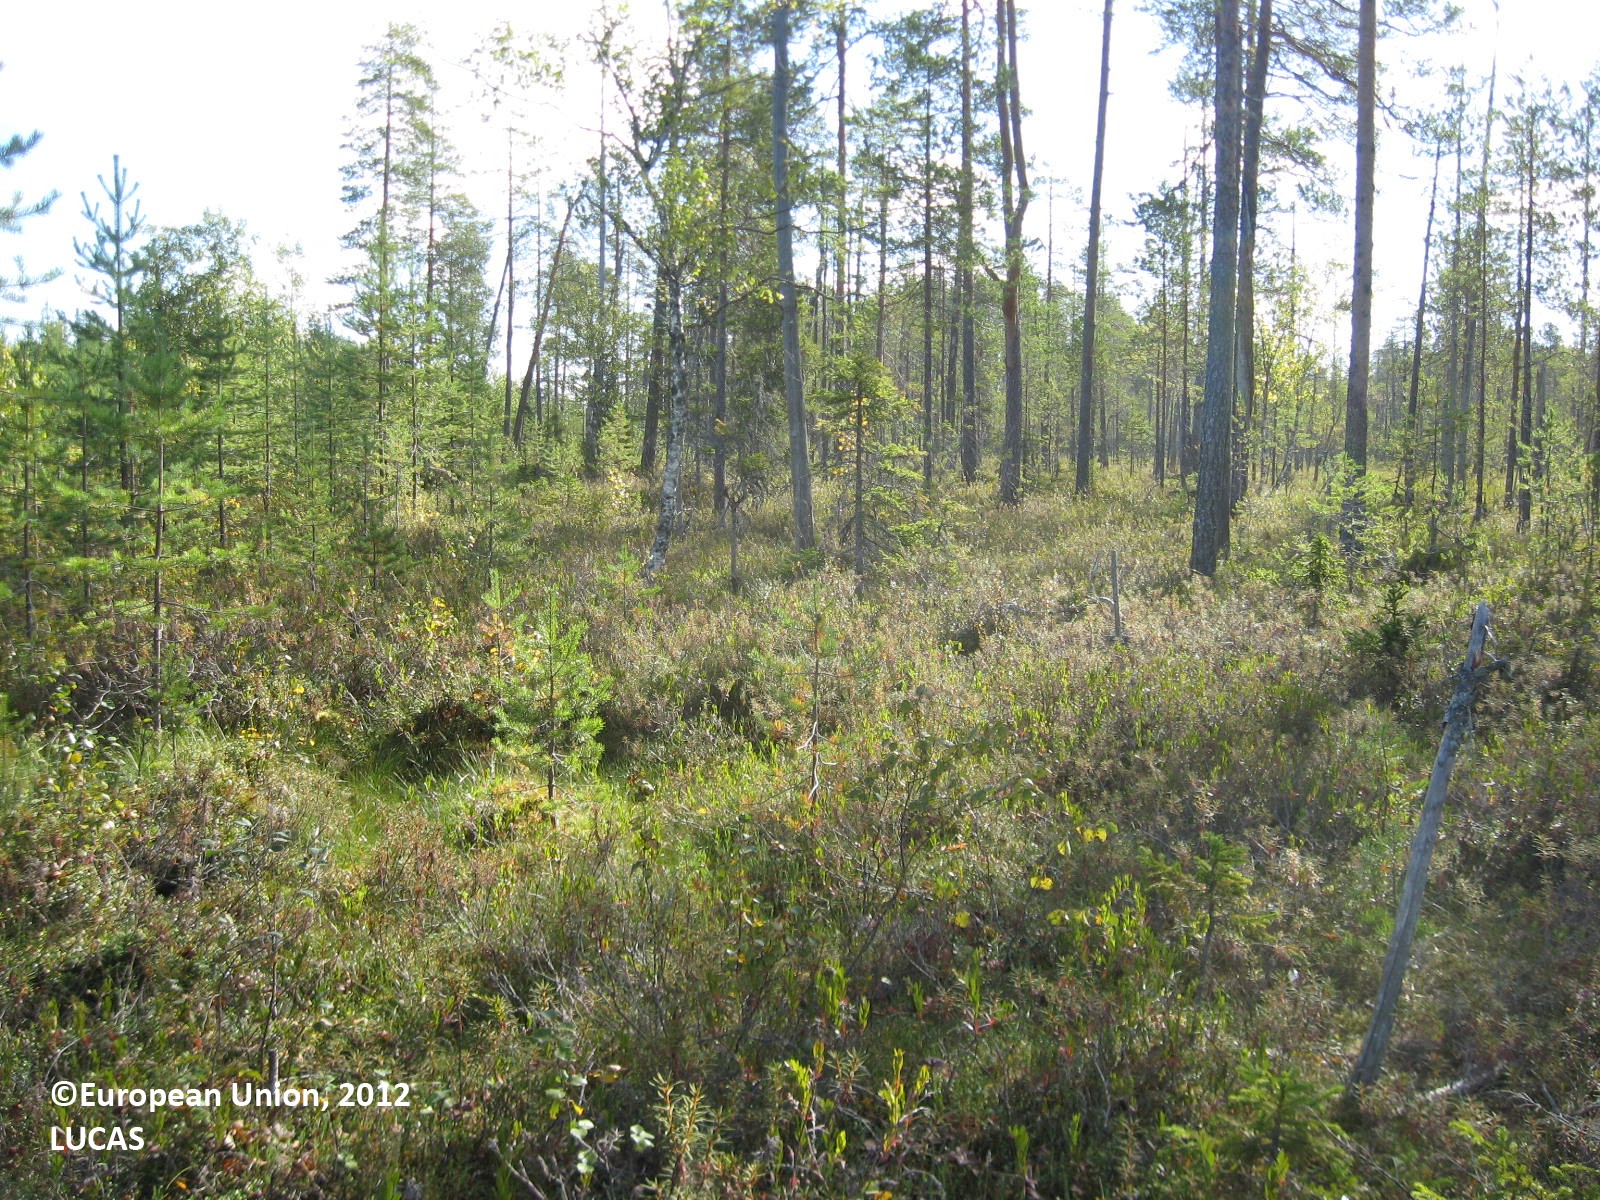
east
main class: Woodland
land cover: Other coniferous woodland
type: boreal forest
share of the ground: 50 - 75 %
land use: Forestry
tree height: < 5 m
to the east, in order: Other coniferous woodland; Pine dominated coniferous woodland
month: August
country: FI
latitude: 63.7930
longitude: 29.7373
